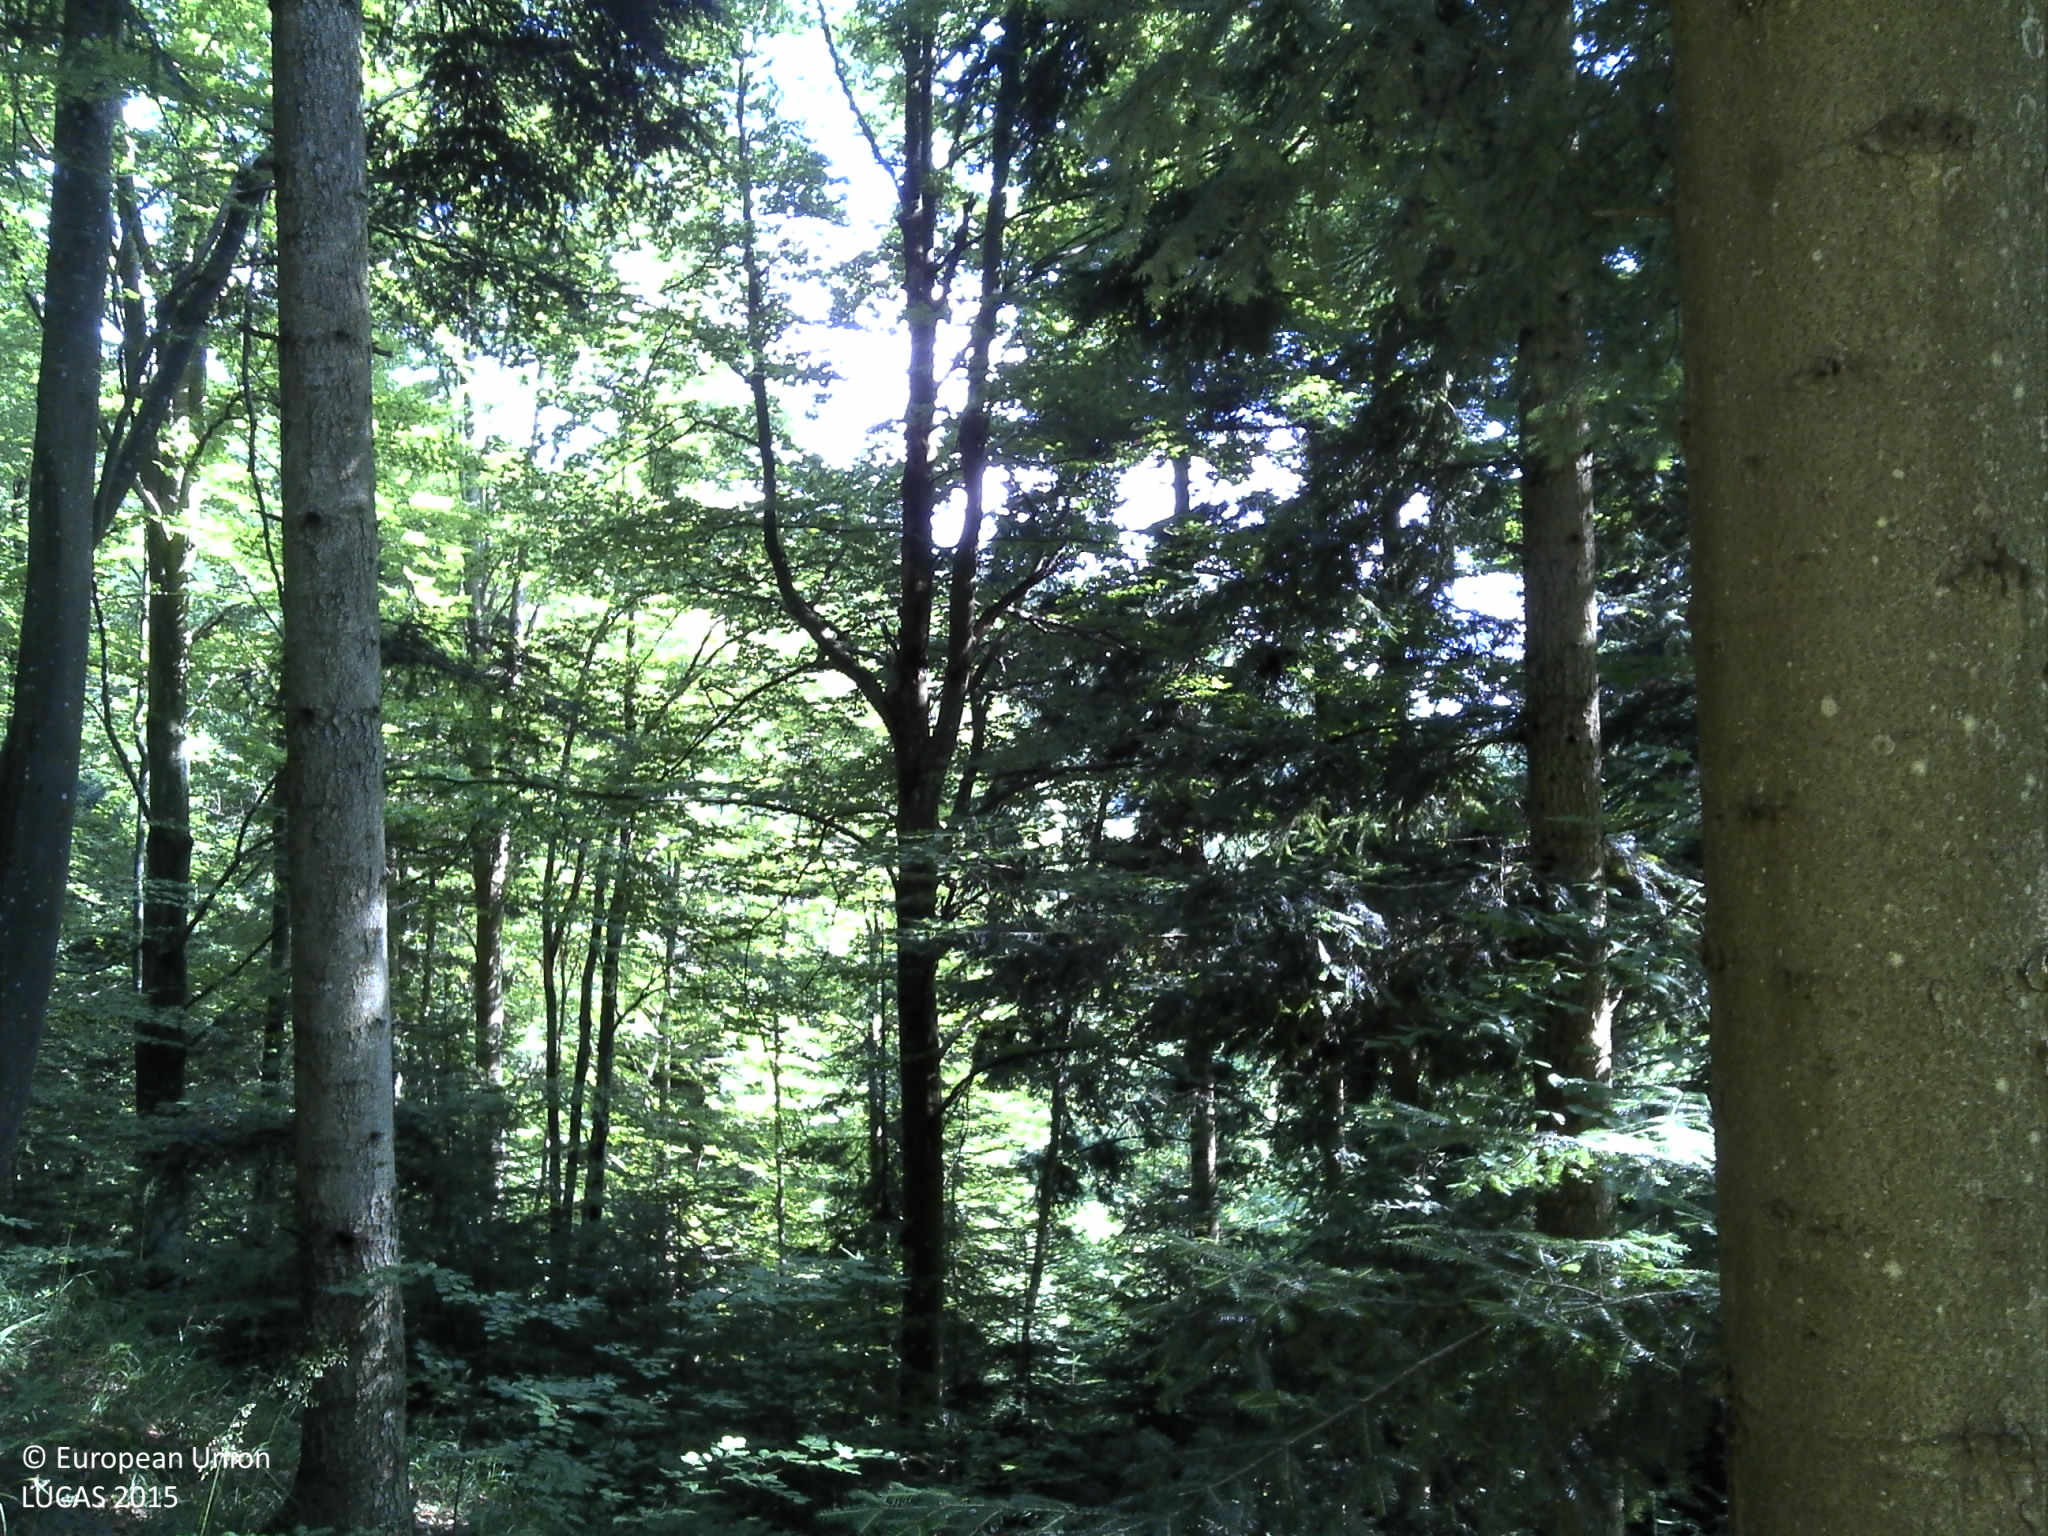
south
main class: Woodland
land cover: Pine dominated mixed woodland
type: broadleaved evergreen forest
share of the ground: > 75 %
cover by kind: coniferous forest trees 50 %, broadleaved forest trees 30 %, lichens and mosses 20 %
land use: Forestry
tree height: > 5 m
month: June
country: HR
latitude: 45.5615
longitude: 17.5222
